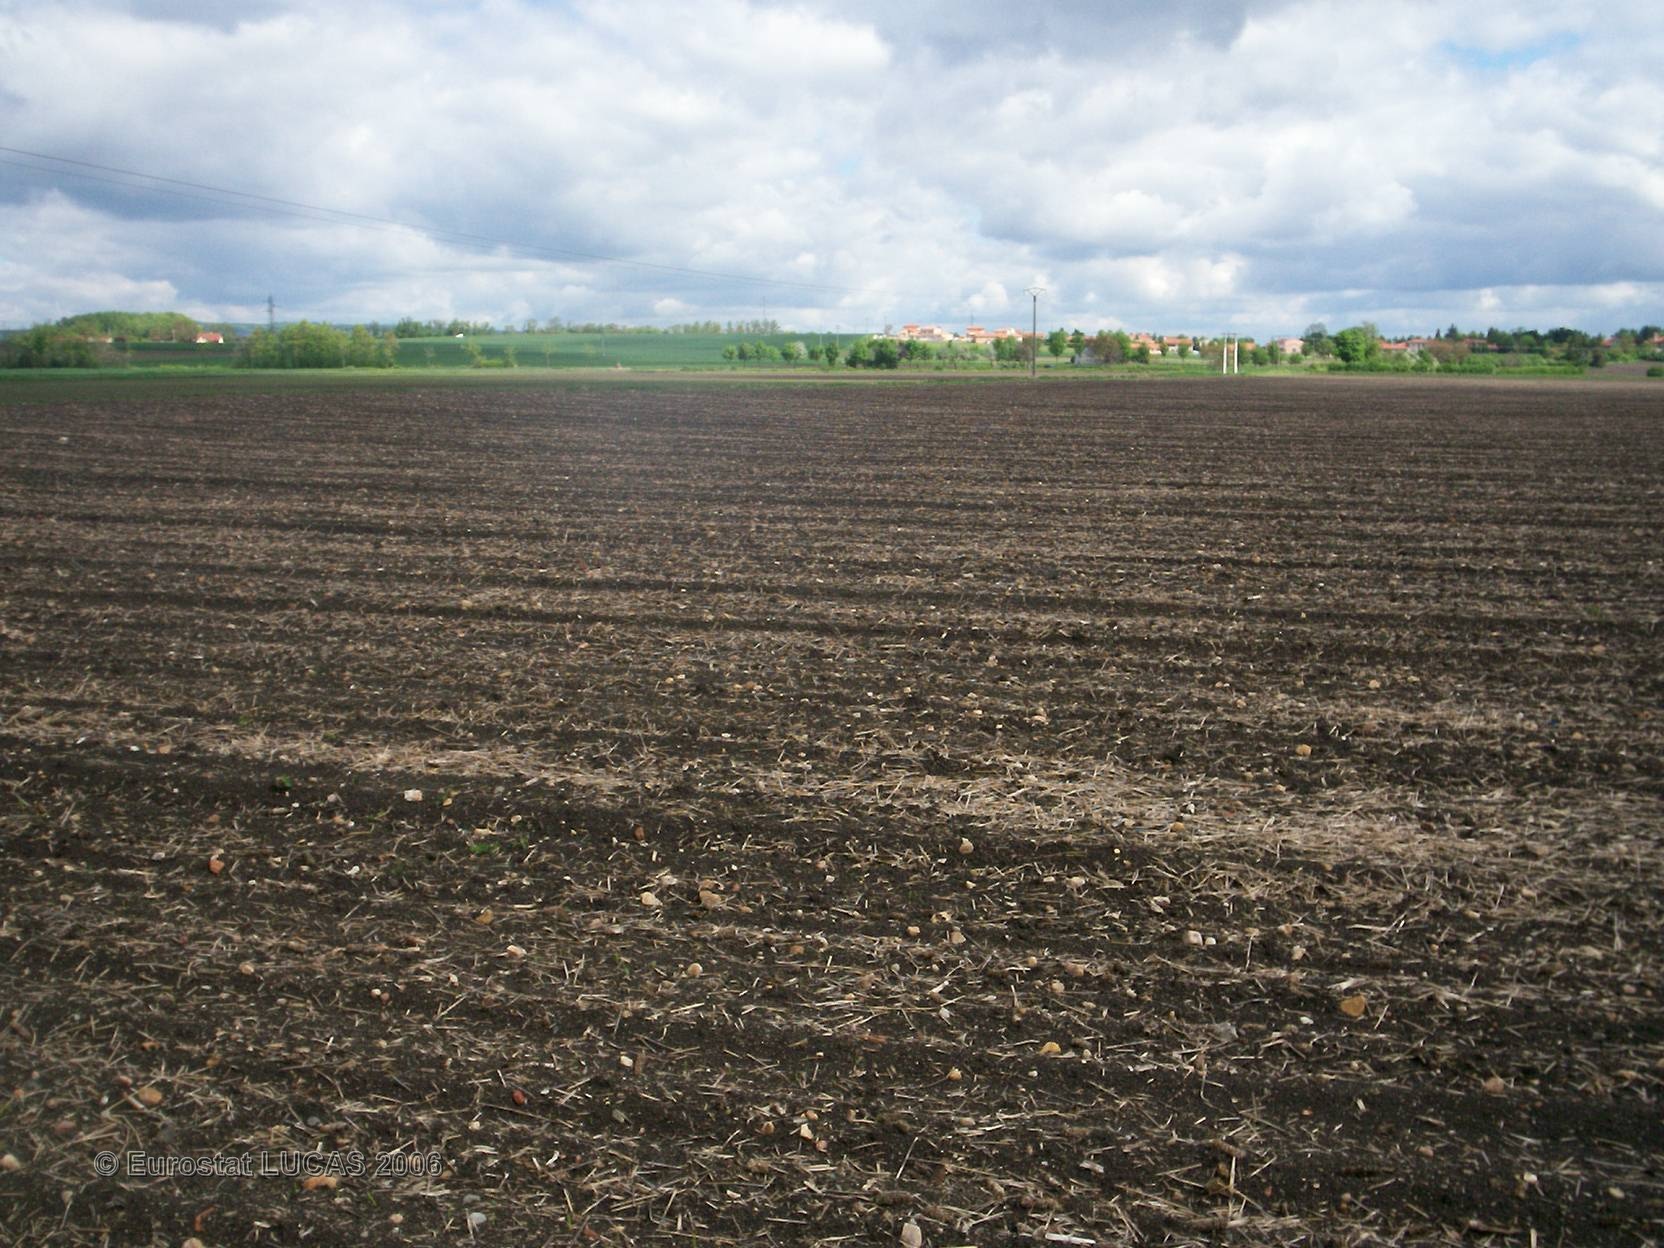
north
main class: Cropland
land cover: Maize
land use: Agriculture (excluding fallow land and kitchen gardens)
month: May
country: FR
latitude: 45.9344
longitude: 3.1769
